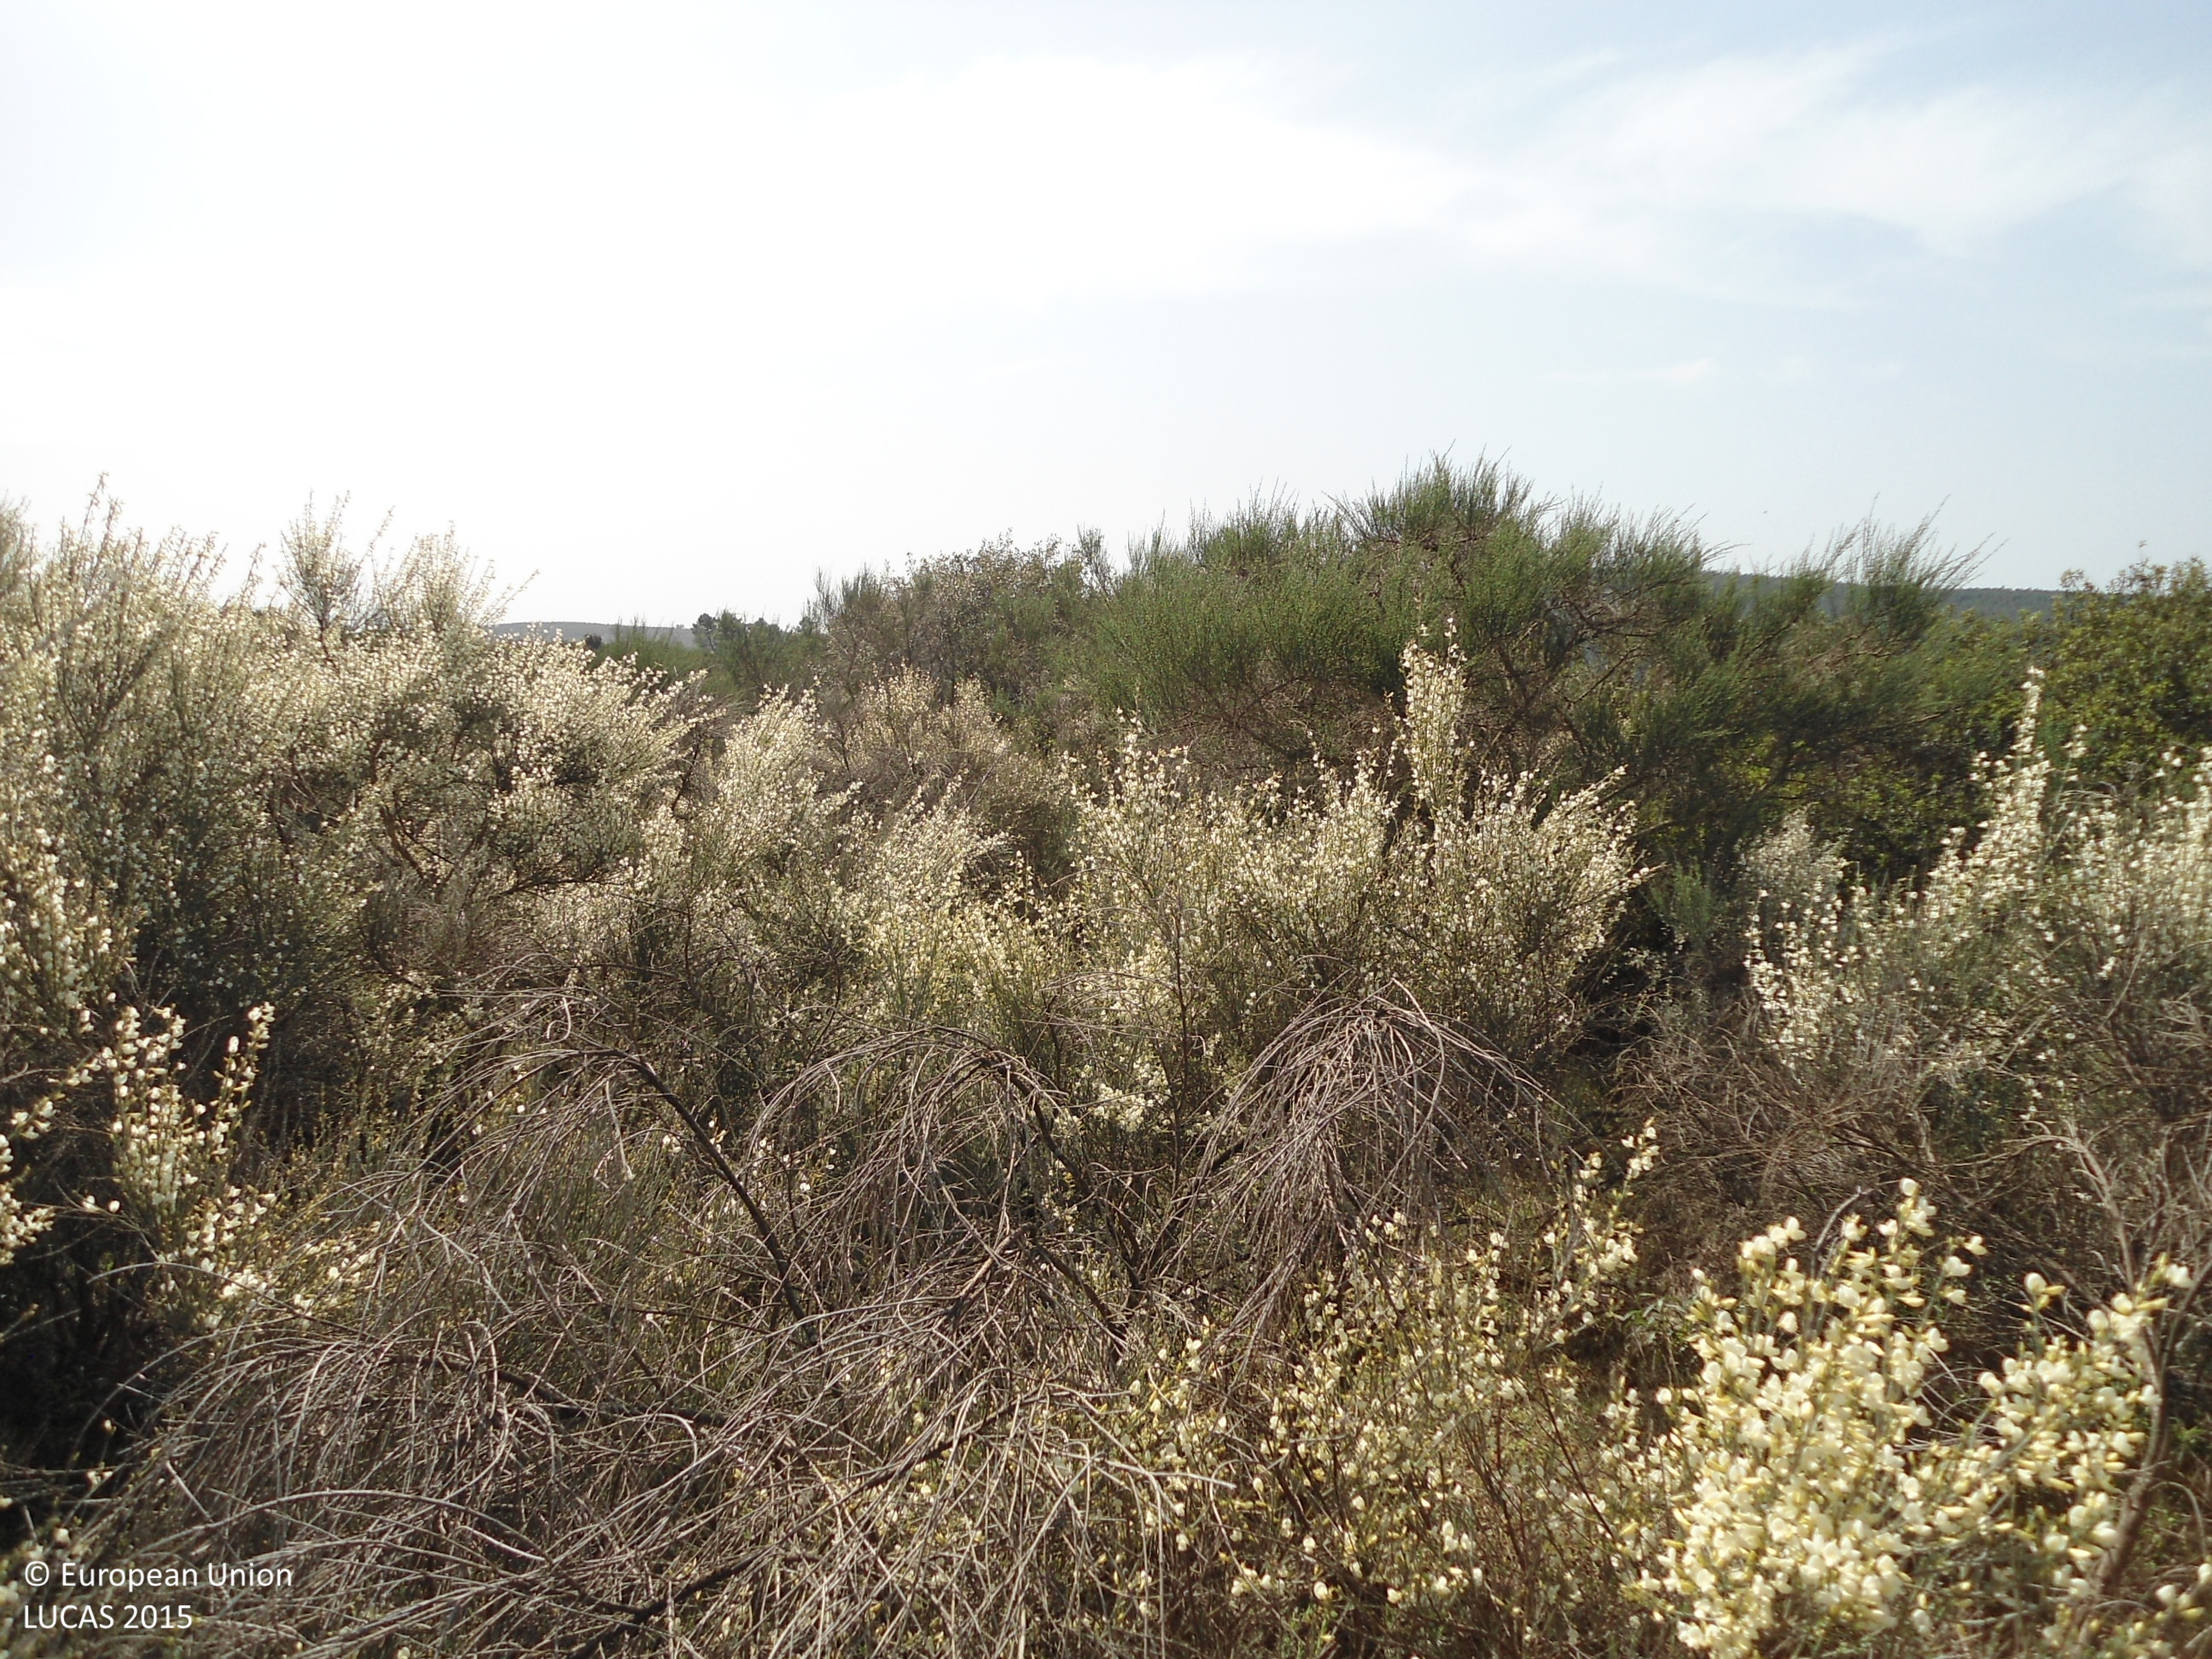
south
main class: Shrubland
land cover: Shrubland without tree cover
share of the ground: > 75 %
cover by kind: shrubs 95 %, herbaceous plants 5 %
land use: Semi-natural and natural areas not in use
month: April
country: ES
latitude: 41.6759
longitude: -6.5017
